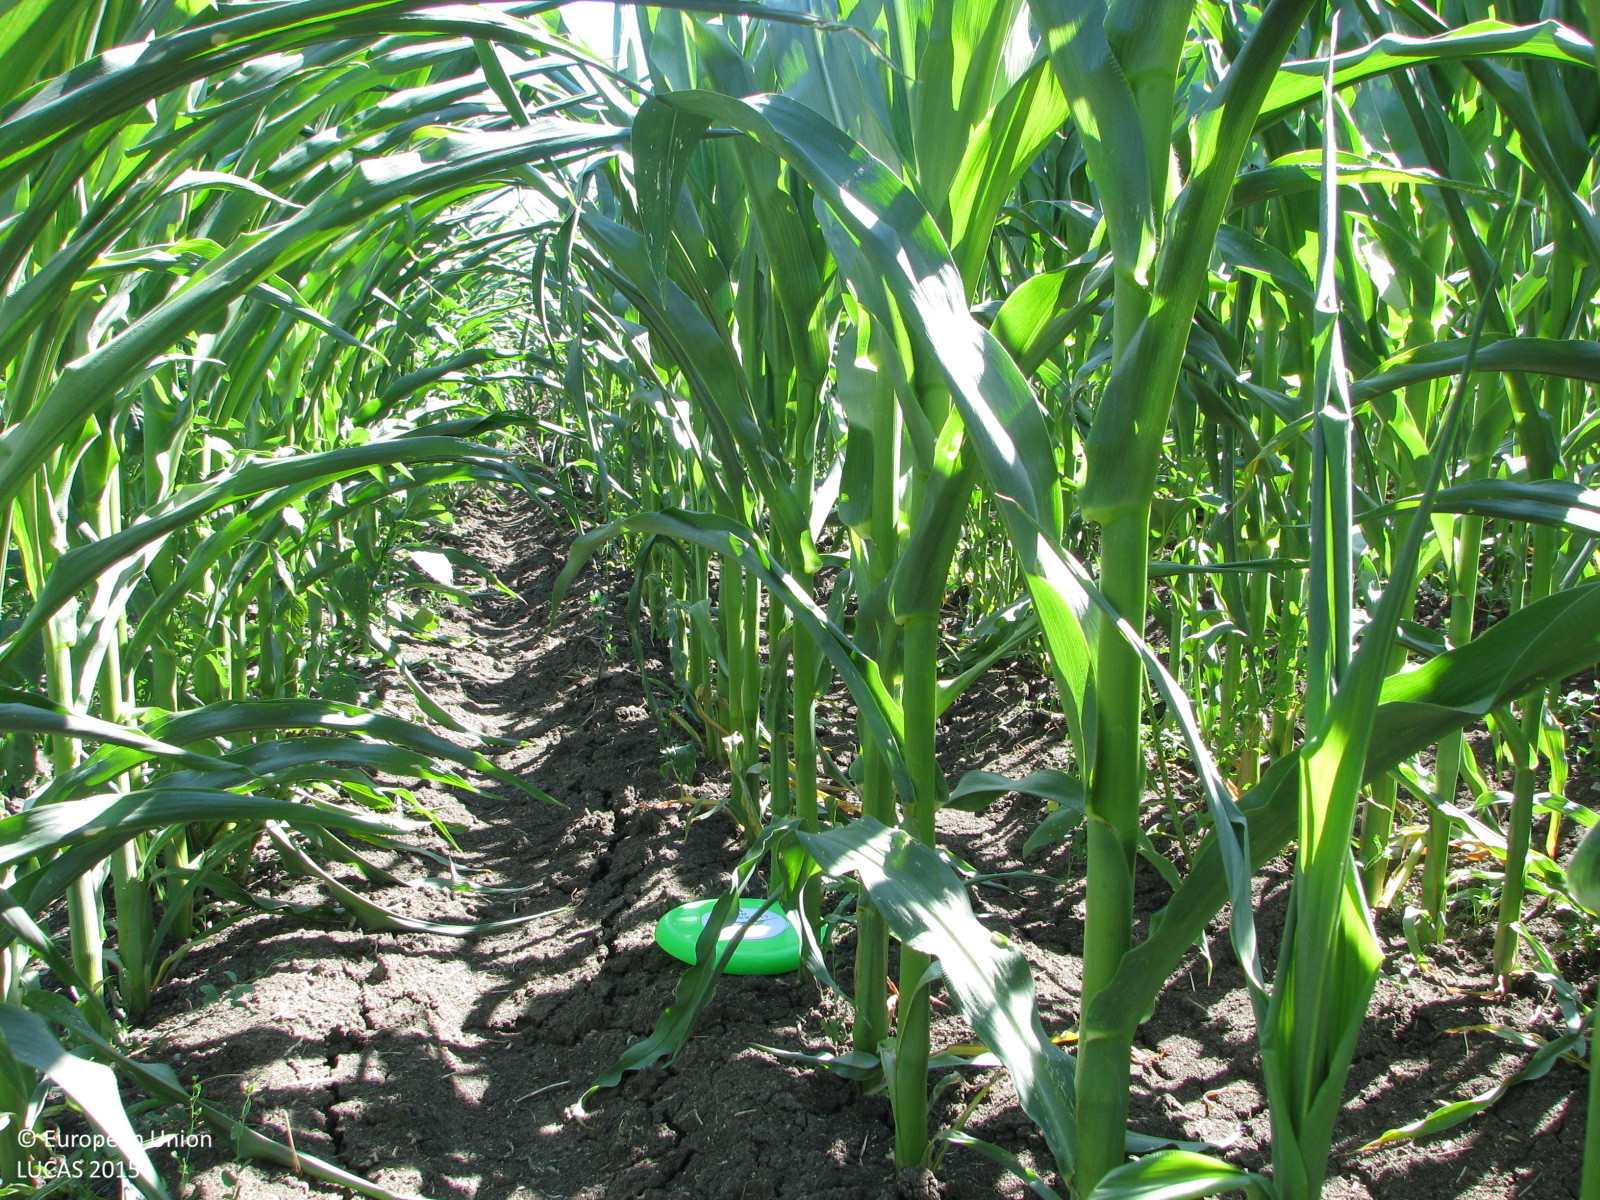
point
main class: Cropland
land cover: Maize
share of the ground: > 75 %
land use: Agriculture (excluding fallow land and kitchen gardens)
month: July
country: BG
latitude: 42.3650
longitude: 25.9978
